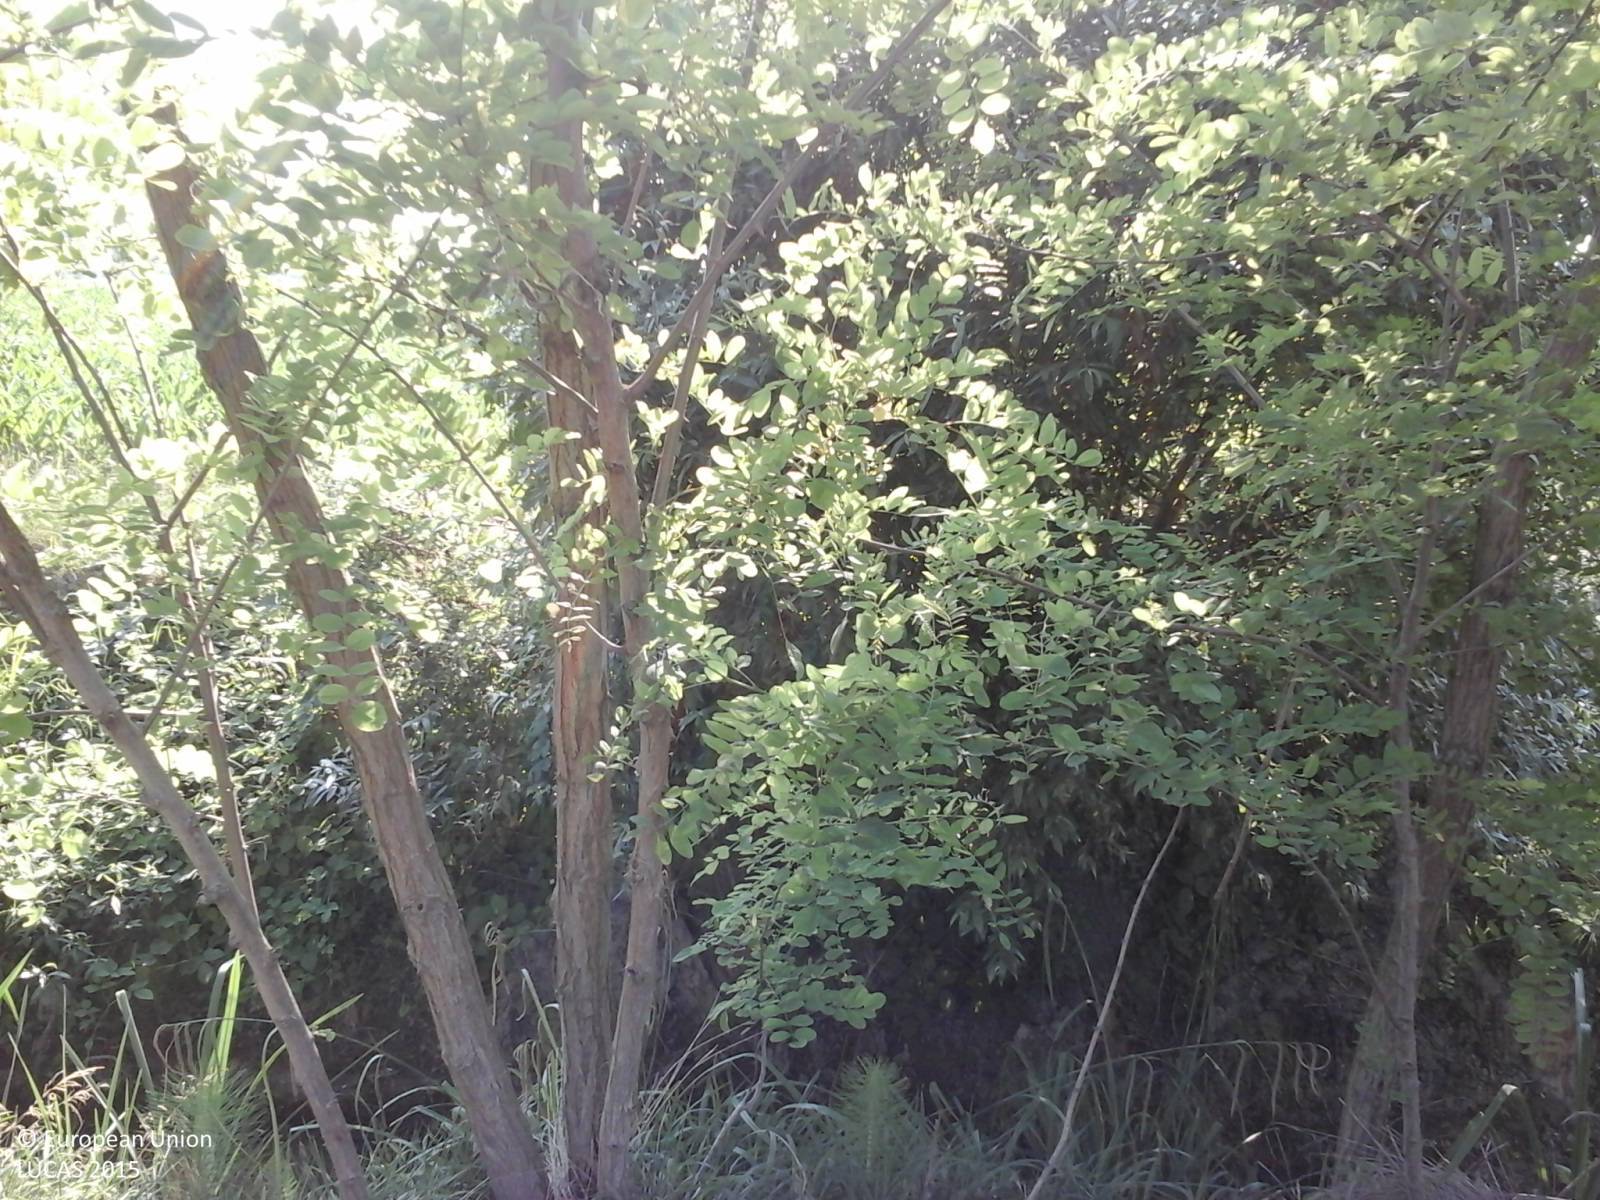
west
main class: Cropland
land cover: Other fresh vegetables
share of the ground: 50 - 75 %
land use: Kitchen garden
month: June
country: IT
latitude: 45.8290
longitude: 13.3816
